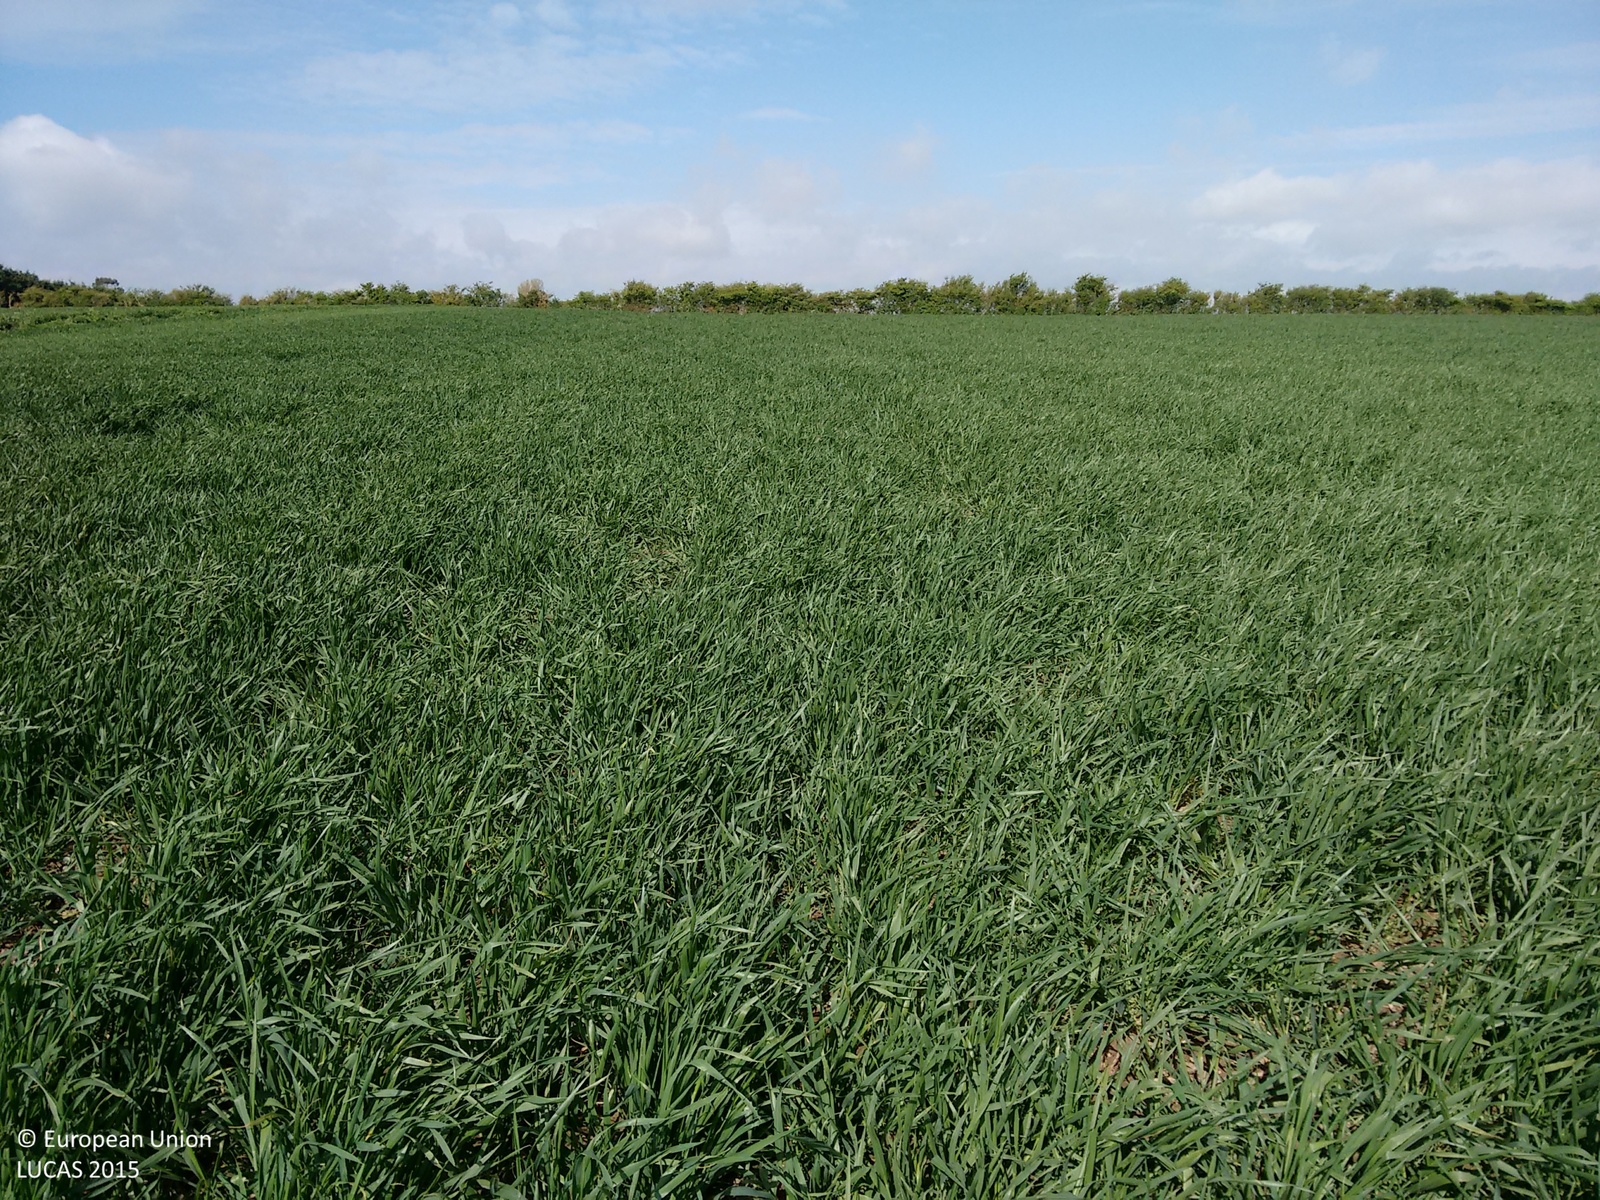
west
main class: Cropland
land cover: Barley
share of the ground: > 75 %
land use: Agriculture (excluding fallow land and kitchen gardens)
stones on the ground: < 10 %
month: May
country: GB
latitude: 53.2605
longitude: 0.2413
